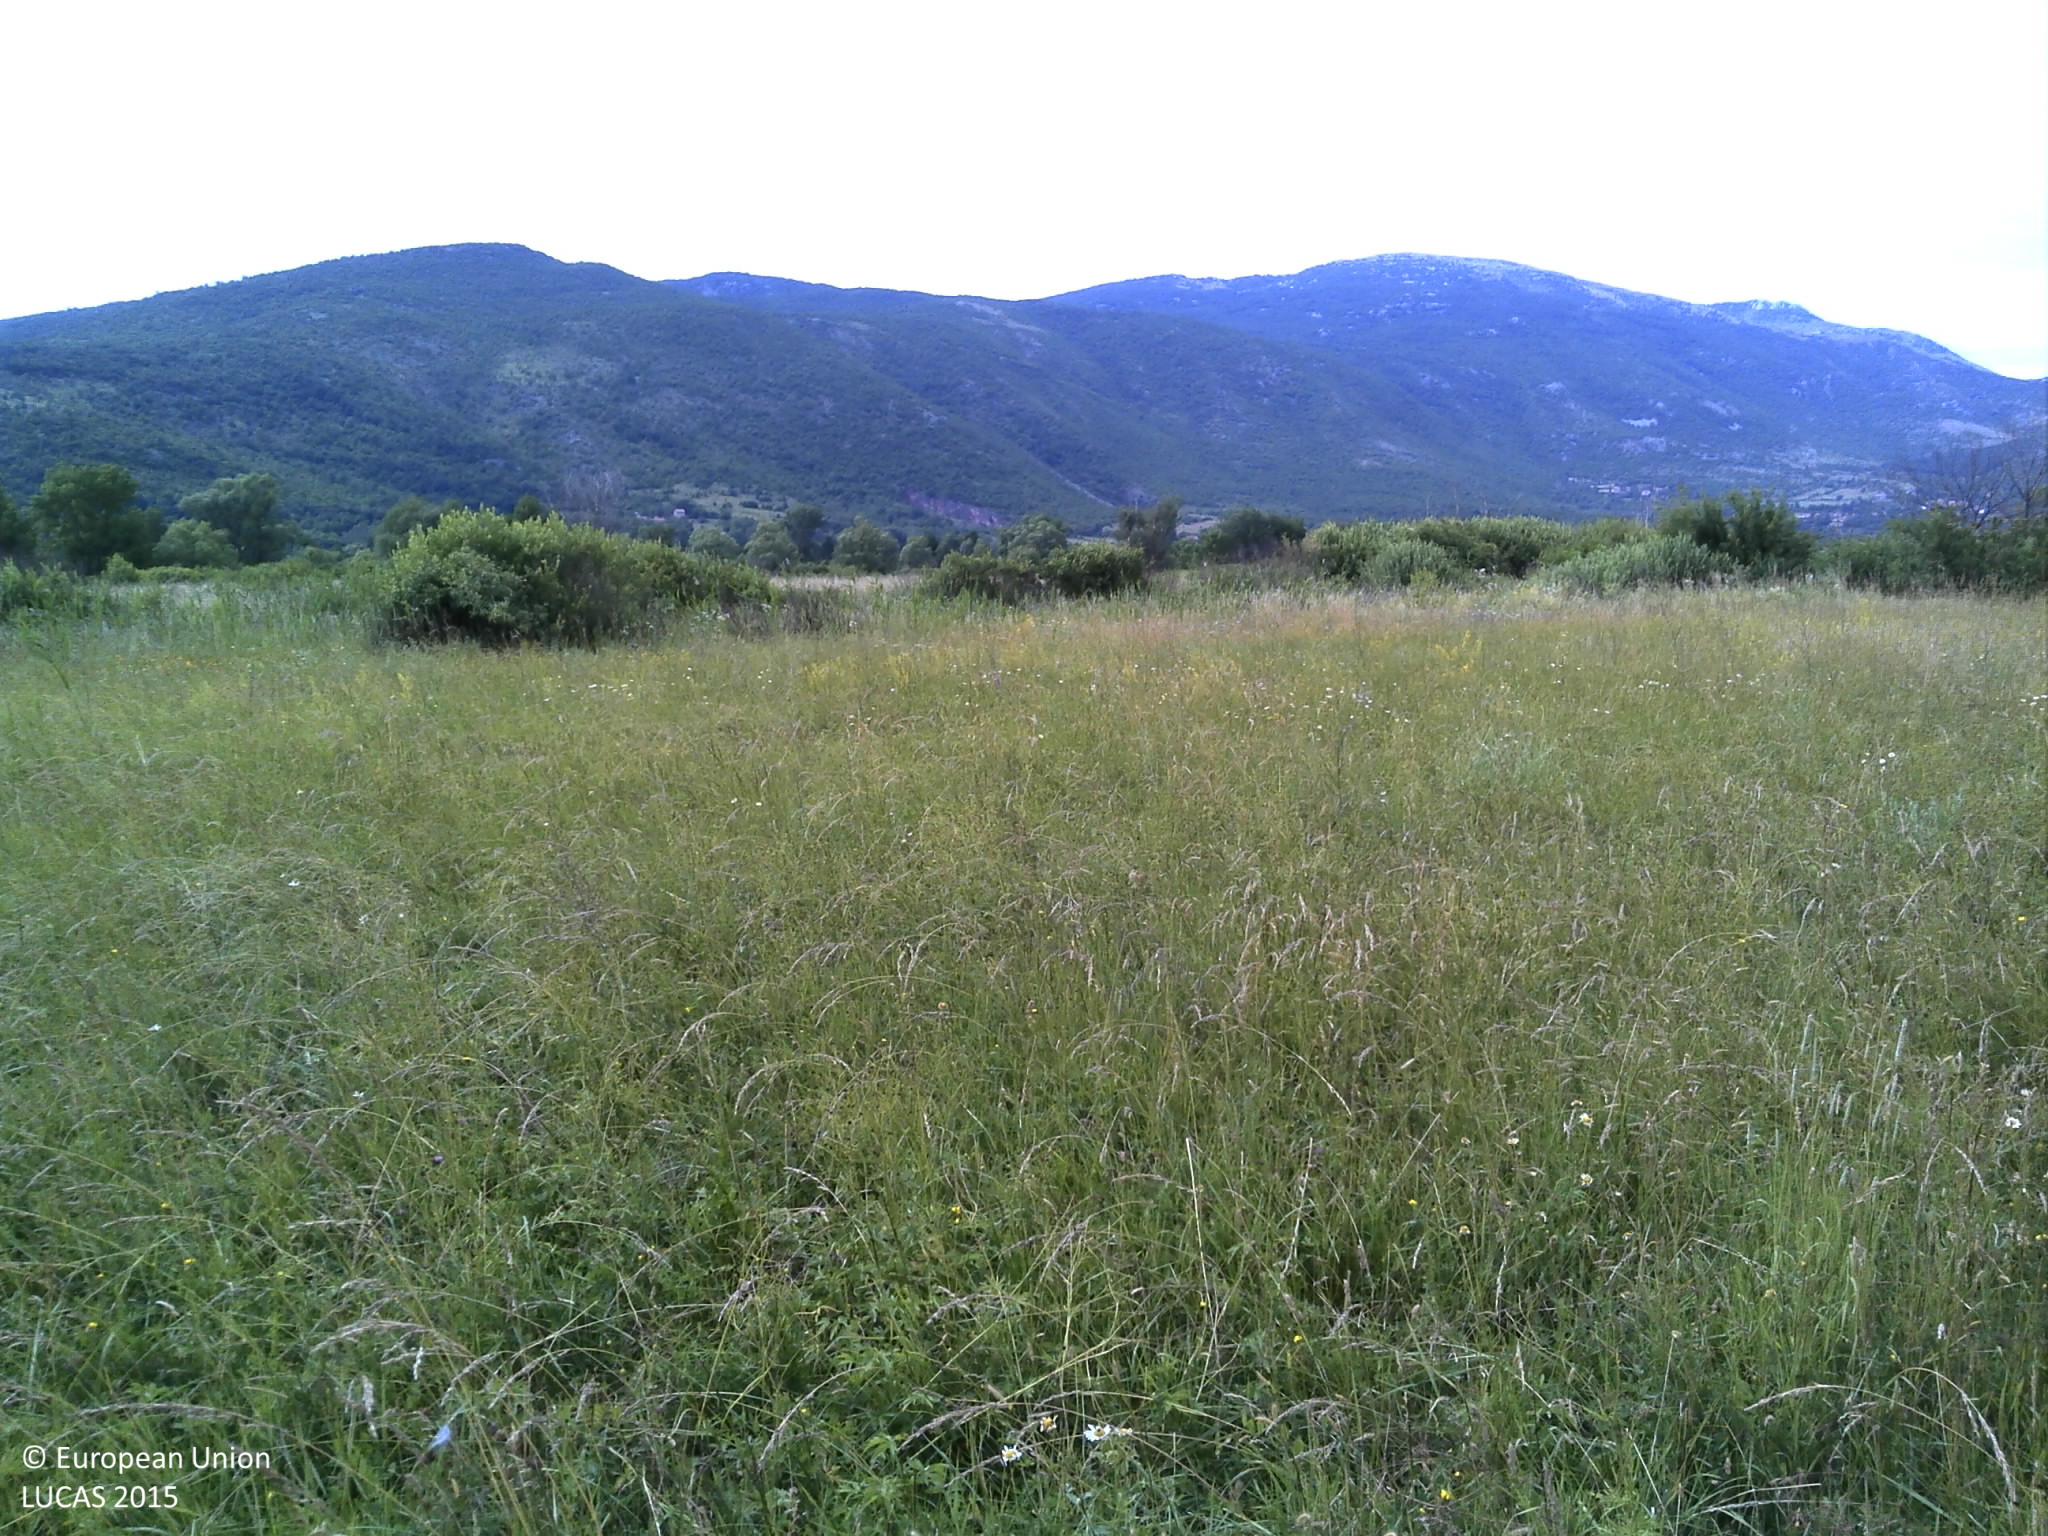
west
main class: Grassland
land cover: Spontaneously vegetated surfaces
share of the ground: > 75 %
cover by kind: herbaceous plants 95 %, shrubs 5 %
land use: Fallow land
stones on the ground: < 10 %
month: June
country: HR
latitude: 44.1496
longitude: 16.1565
